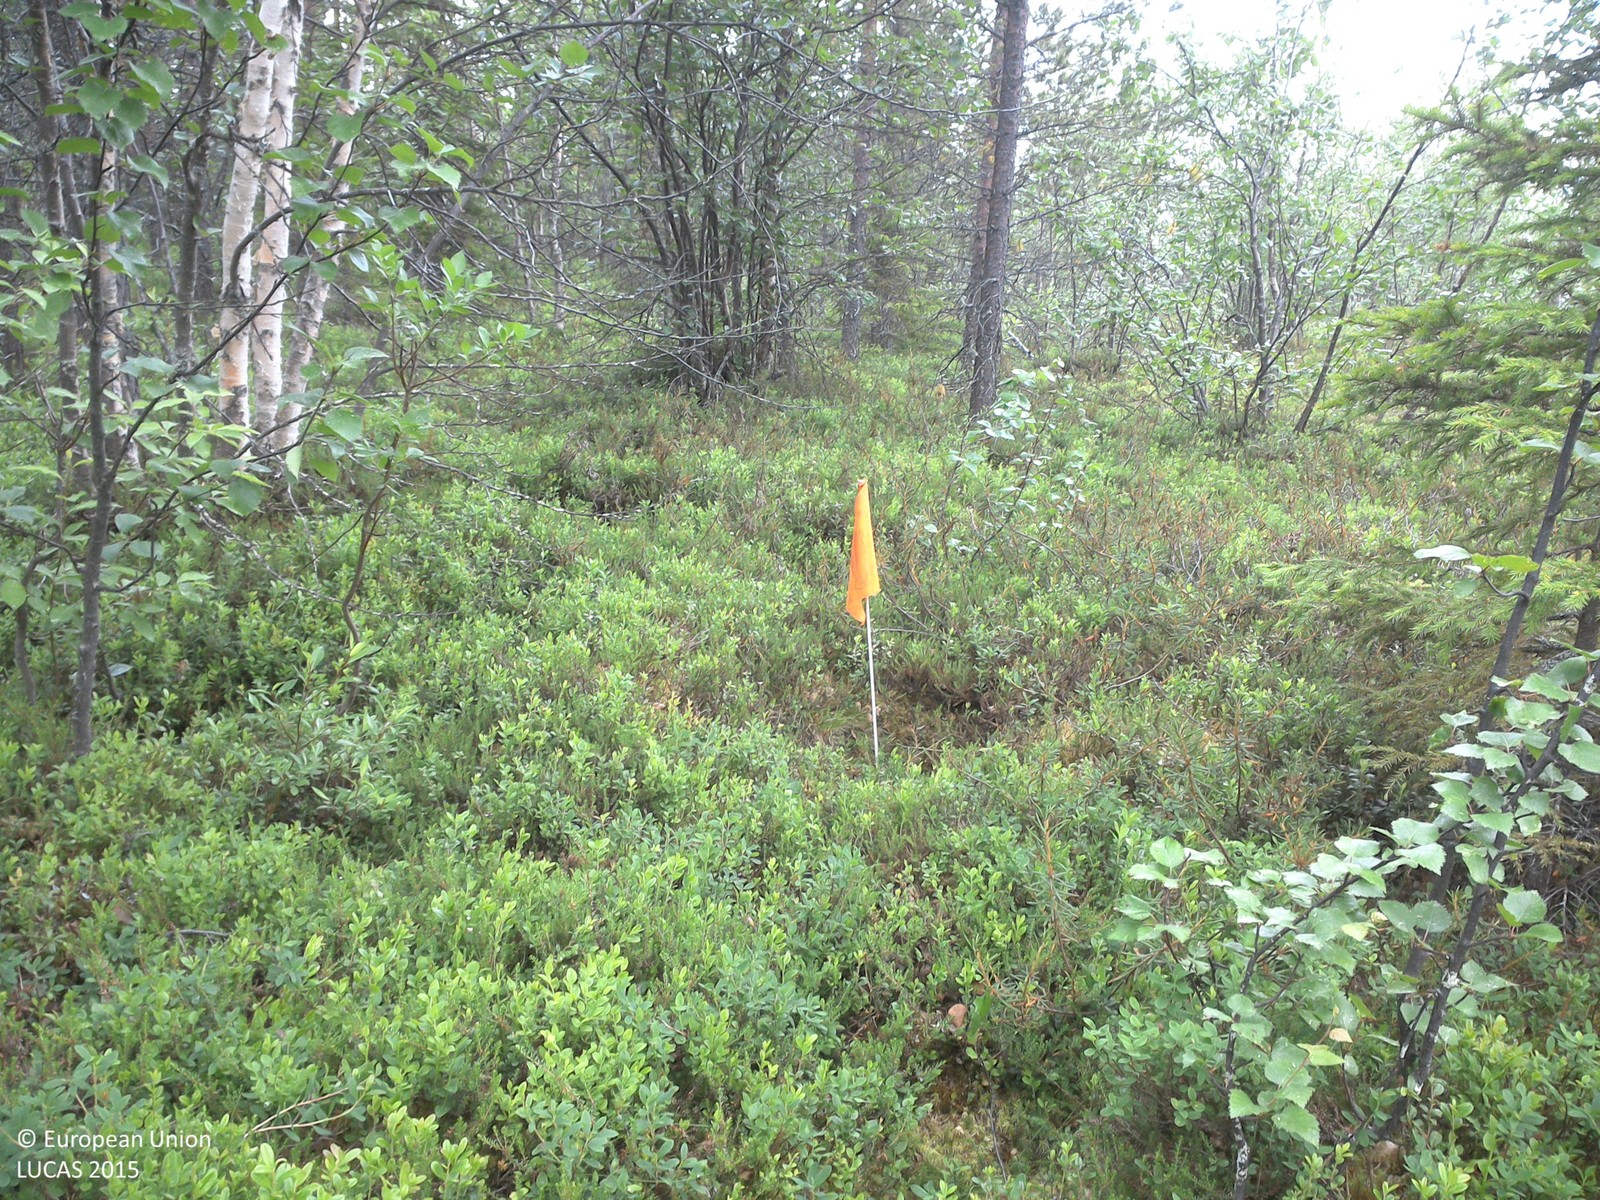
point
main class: Woodland
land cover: Pine dominated mixed woodland
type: boreal forest
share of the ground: 25 - 50 %
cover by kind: shrubs 60 %, coniferous forest trees 20 %, broadleaved forest trees 15 %, lichens and mosses 5 %
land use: Forestry
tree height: > 5 m
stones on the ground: < 10 %
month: July
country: SE
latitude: 67.8061
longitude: 22.3589
